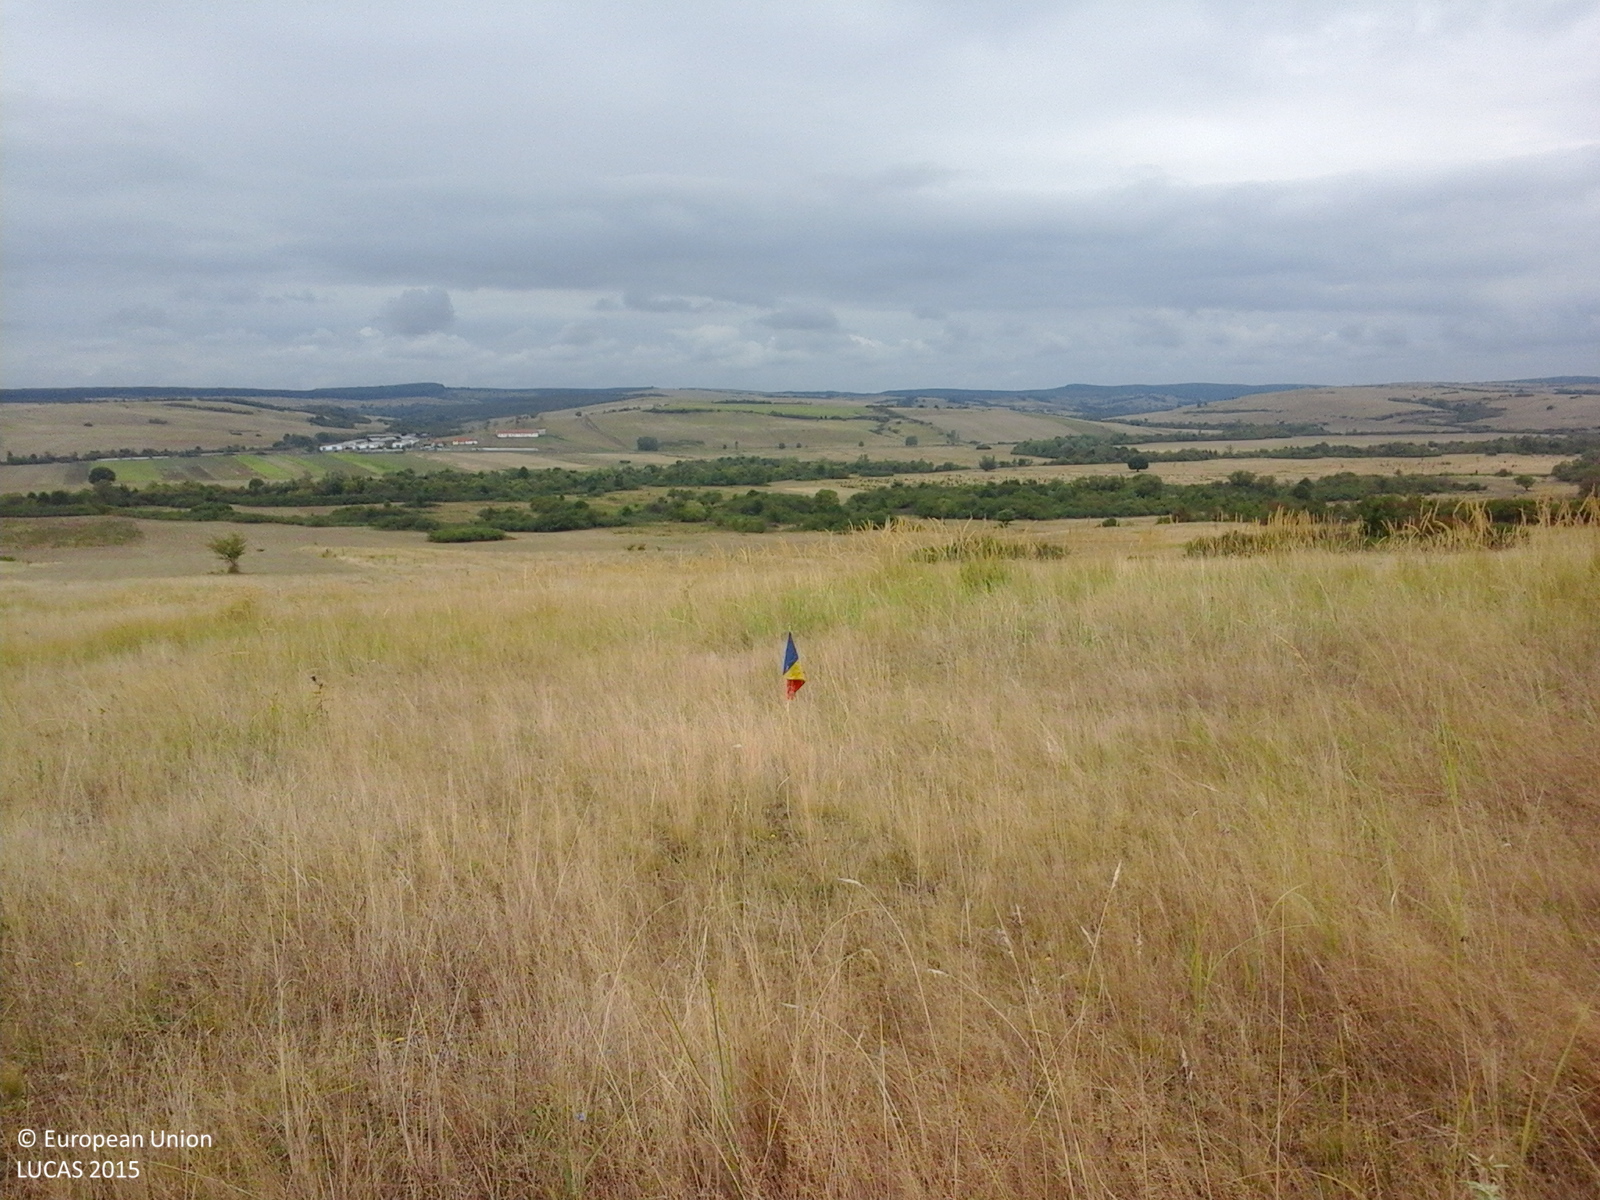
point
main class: Grassland
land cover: Grassland without tree/shrub cover
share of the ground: > 75 %
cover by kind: herbaceous plants 100 %
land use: Agriculture (excluding fallow land and kitchen gardens)
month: August
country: RO
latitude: 45.8567
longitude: 21.8228
